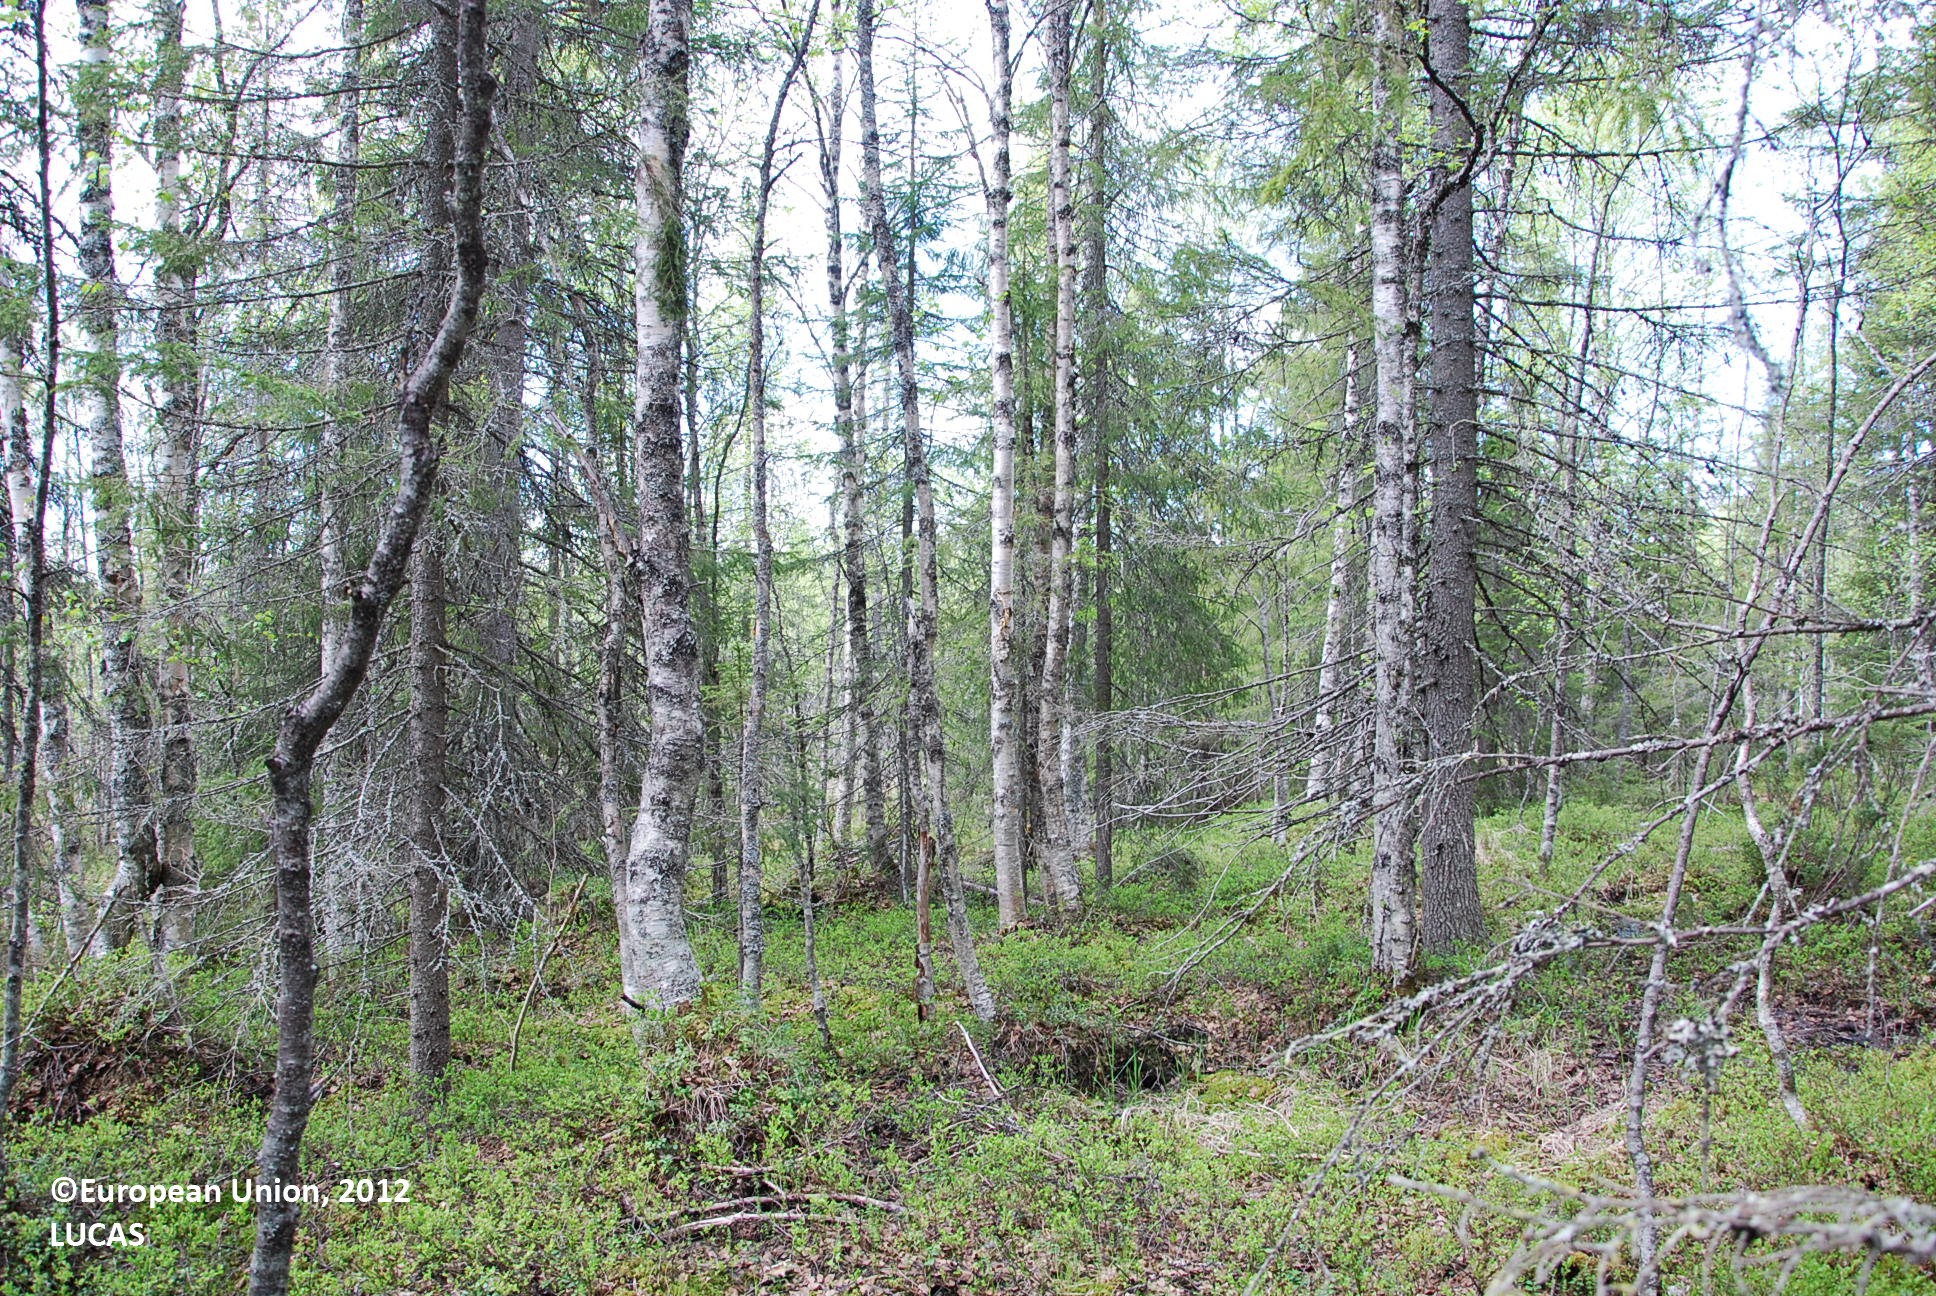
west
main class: Woodland
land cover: Spruce dominated mixed woodland
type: boreal forest
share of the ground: > 75 %
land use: Forestry
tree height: > 5 m
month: June
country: FI
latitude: 66.2062
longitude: 27.6949
